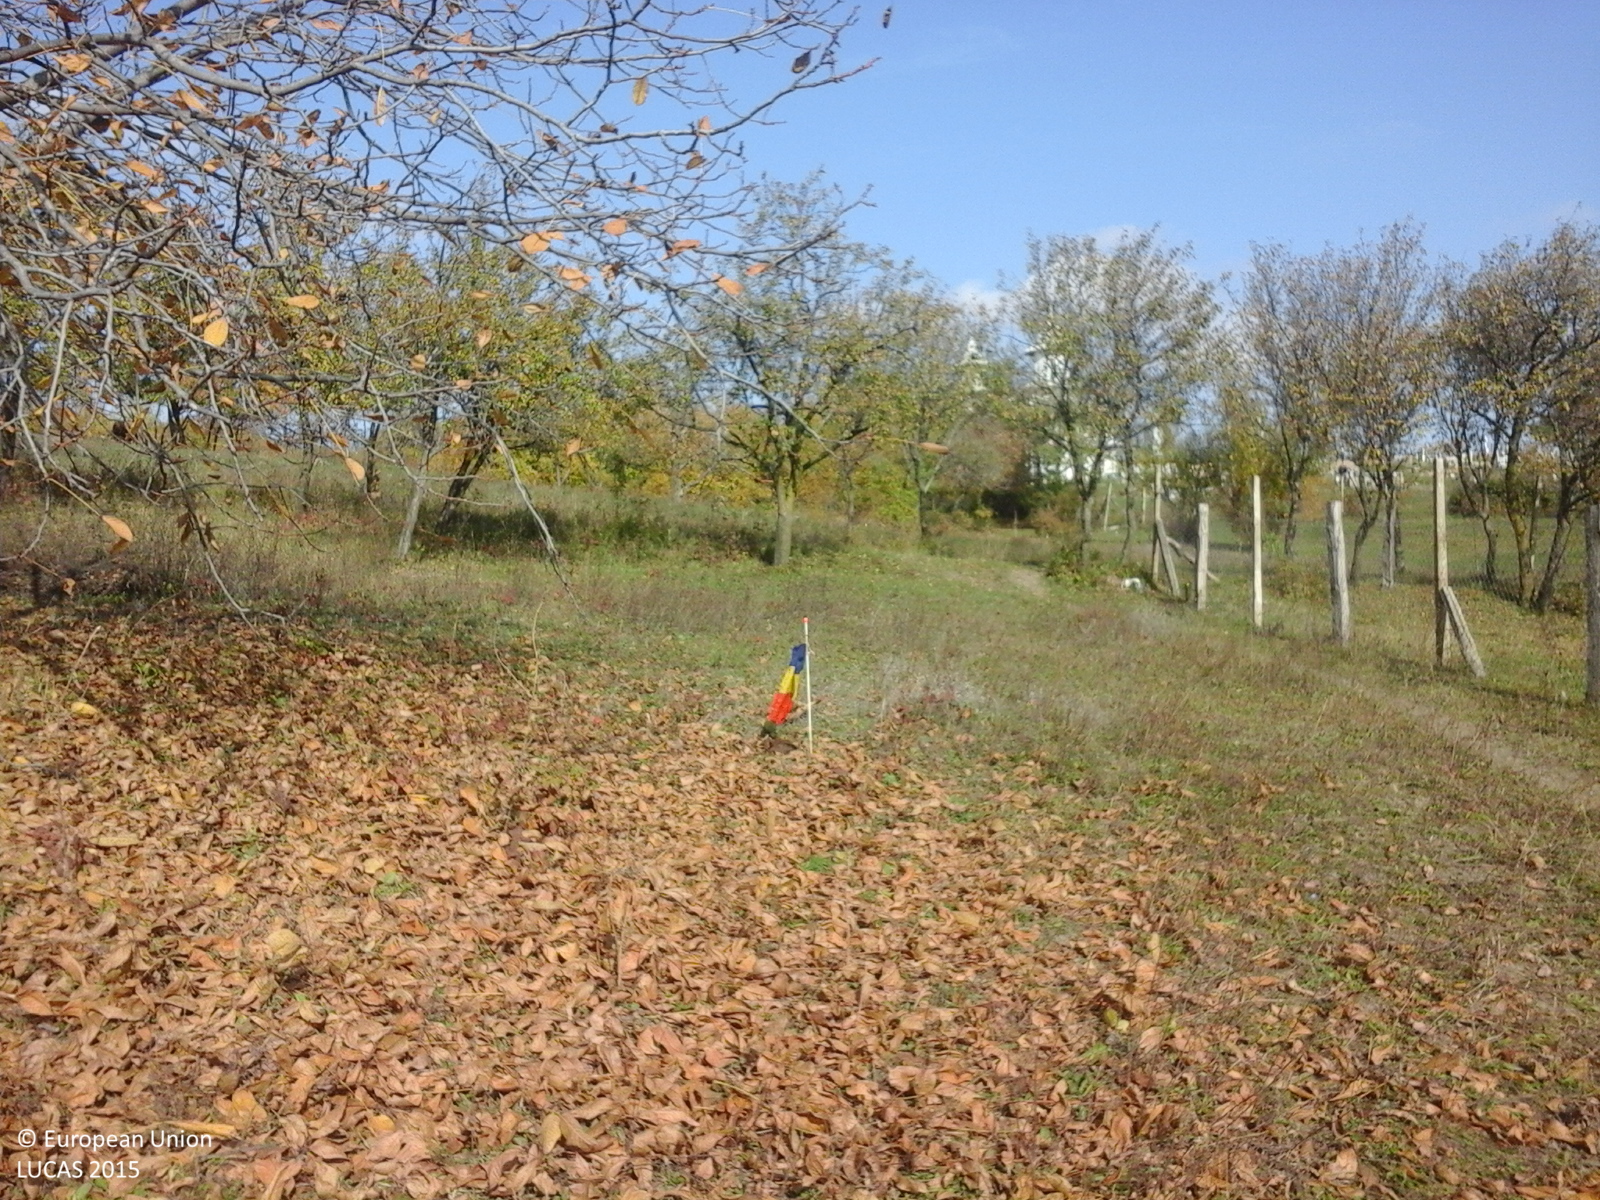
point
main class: Cropland
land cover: Nuts trees
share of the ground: > 75 %
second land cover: Grassland without tree/shrub cover
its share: > 75 %
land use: Agriculture (excluding fallow land and kitchen gardens)
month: October
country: RO
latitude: 45.6594
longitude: 26.9913
